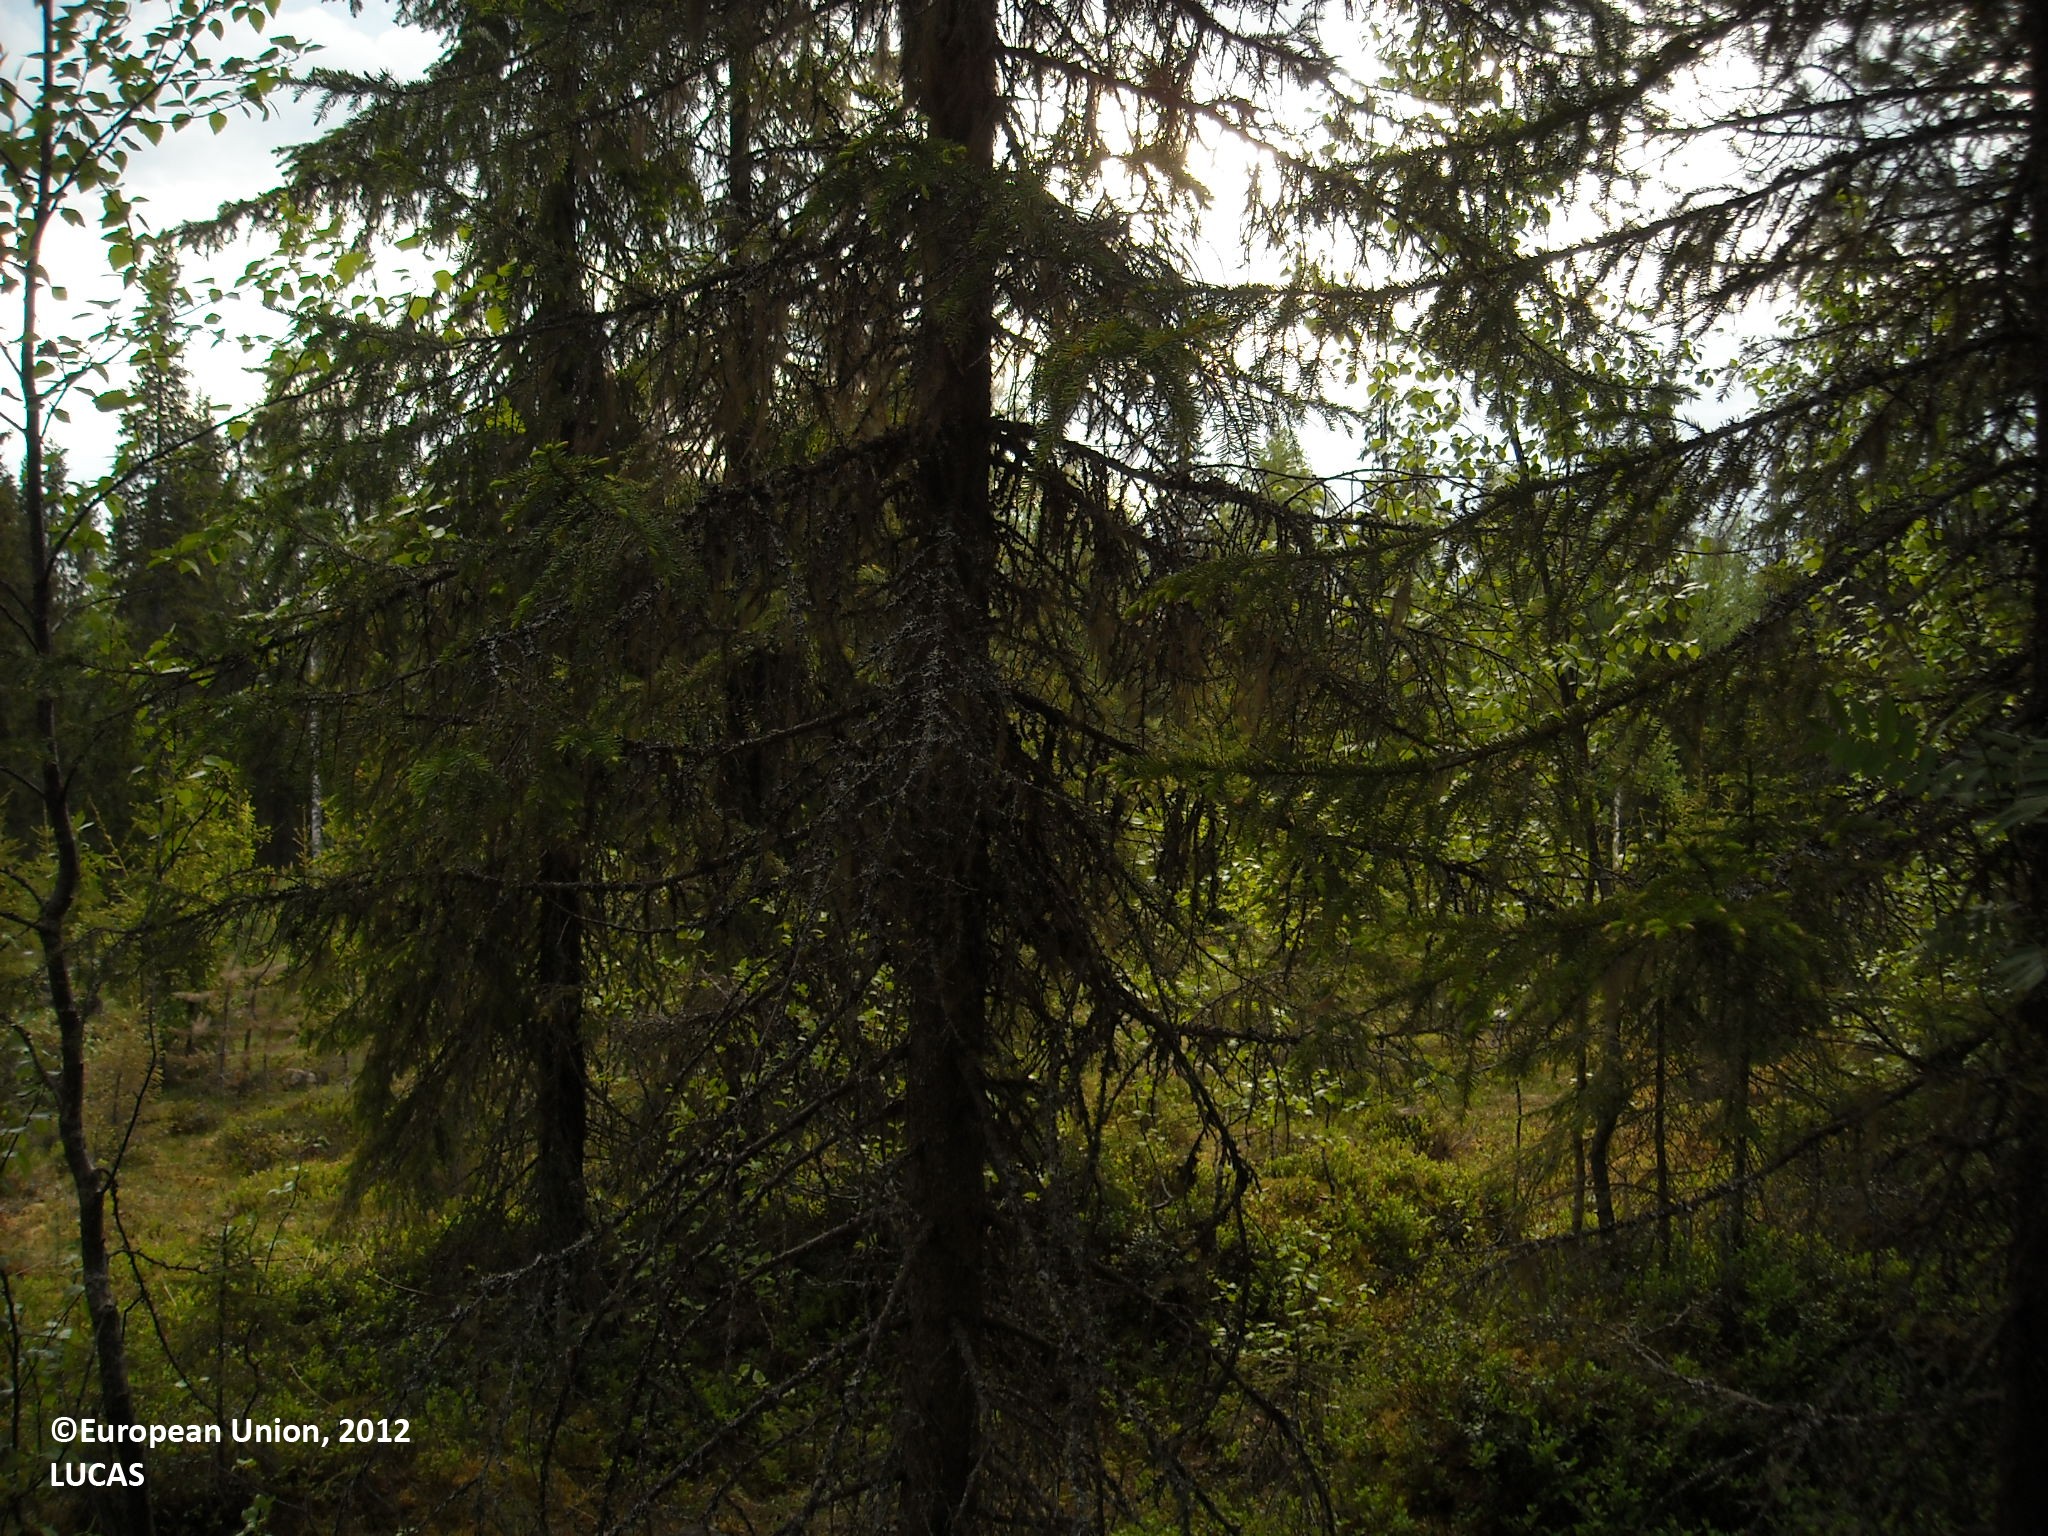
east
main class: Woodland
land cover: Other mixed woodland
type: boreal forest
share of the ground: > 75 %
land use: Forestry
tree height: > 5 m
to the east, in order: Other mixed woodland; Spruce dominated mixed woodland; Rivers and streams; Spruce dominated mixed woodland
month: June
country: FI
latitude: 65.6637
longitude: 28.0419
